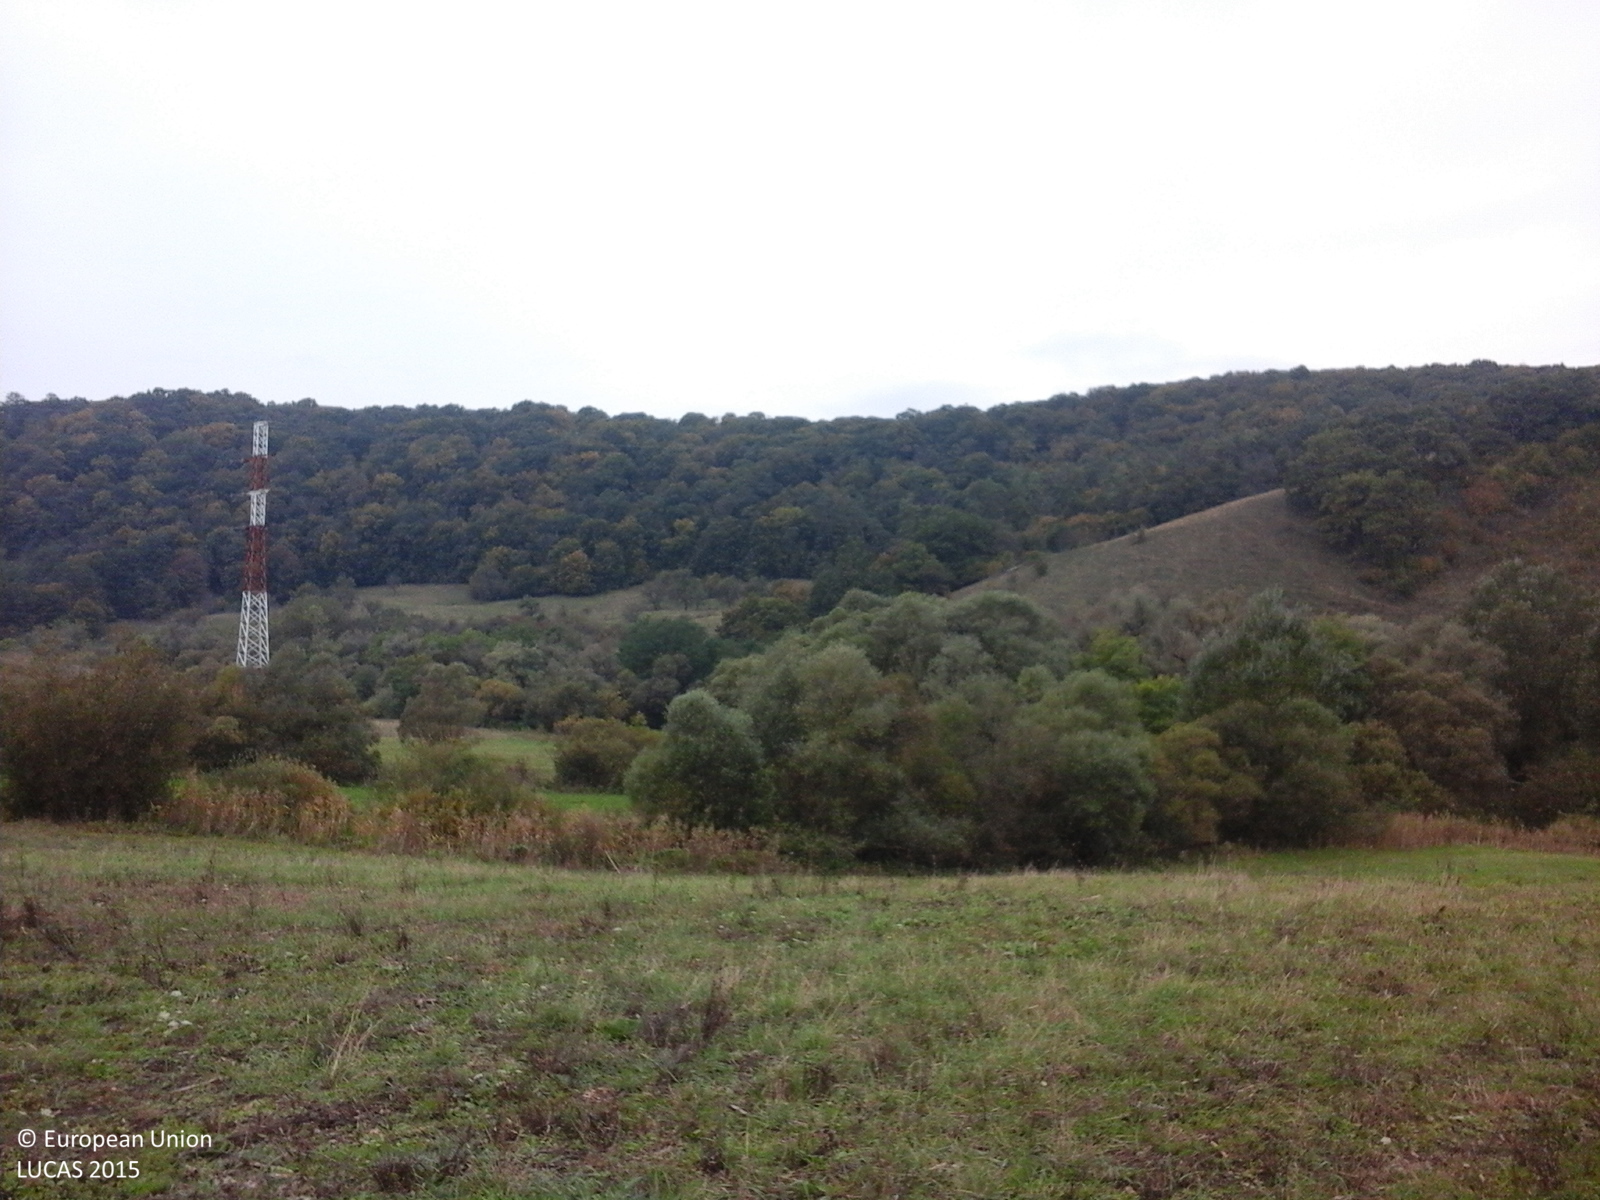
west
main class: Grassland
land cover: Grassland without tree/shrub cover
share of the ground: > 75 %
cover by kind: herbaceous plants 100 %
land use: Agriculture (excluding fallow land and kitchen gardens)
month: October
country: RO
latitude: 46.1433
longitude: 25.0219
